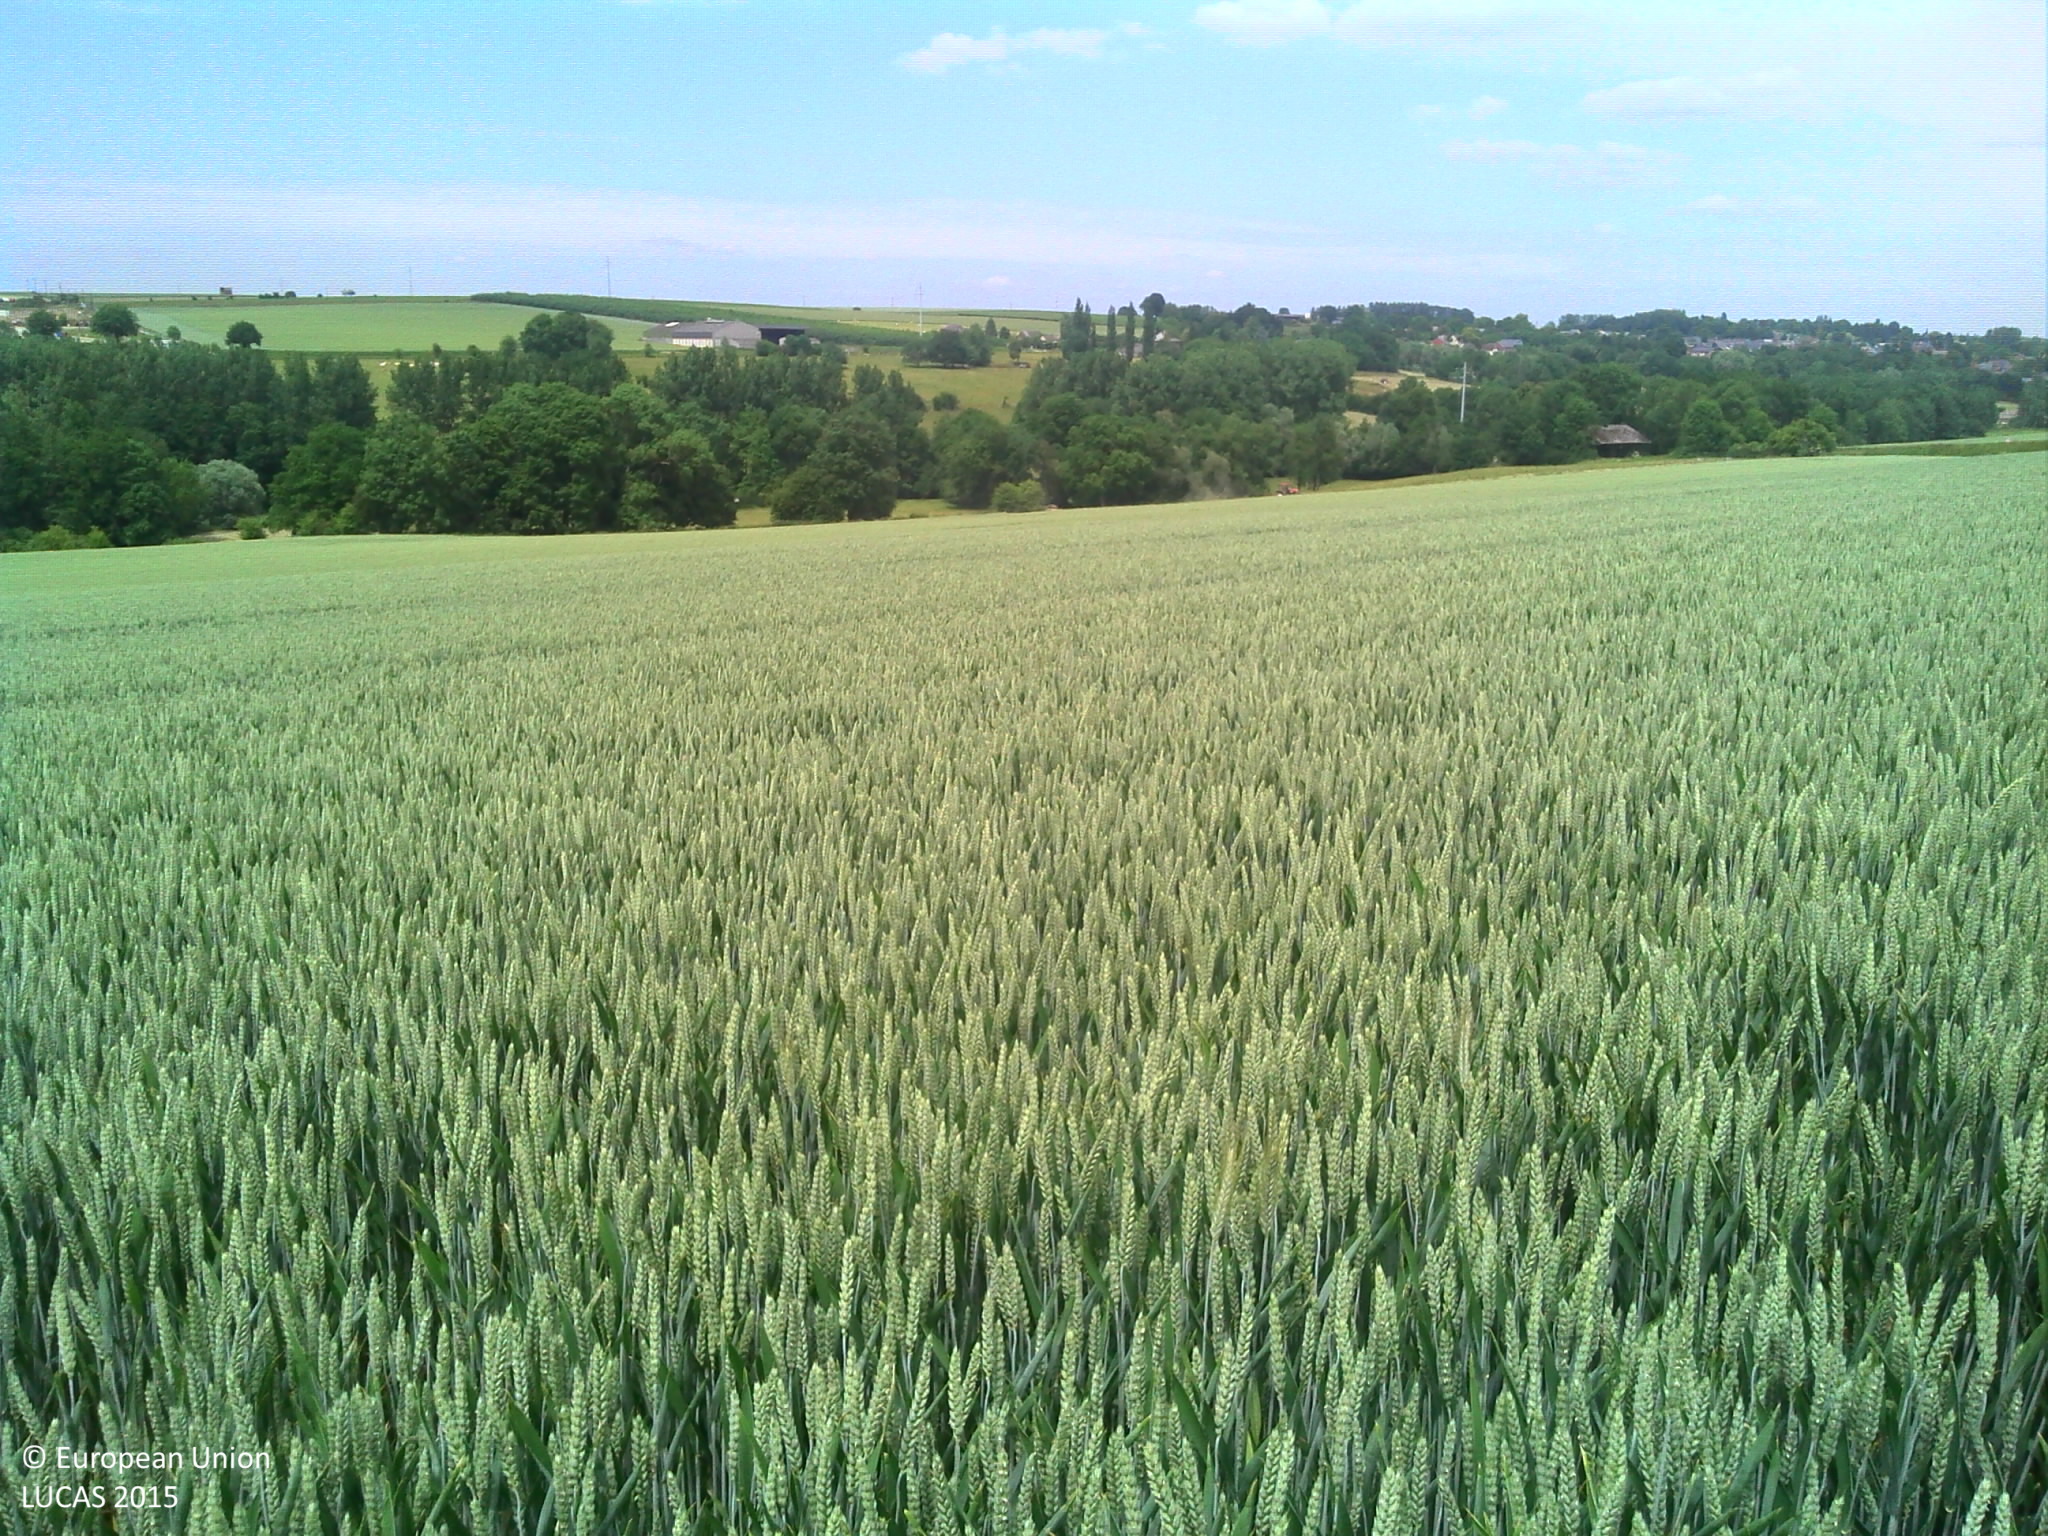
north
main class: Cropland
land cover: Rape and turnip rape
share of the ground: > 75 %
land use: Agriculture (excluding fallow land and kitchen gardens)
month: June
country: FR
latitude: 49.7922
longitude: 4.0075
